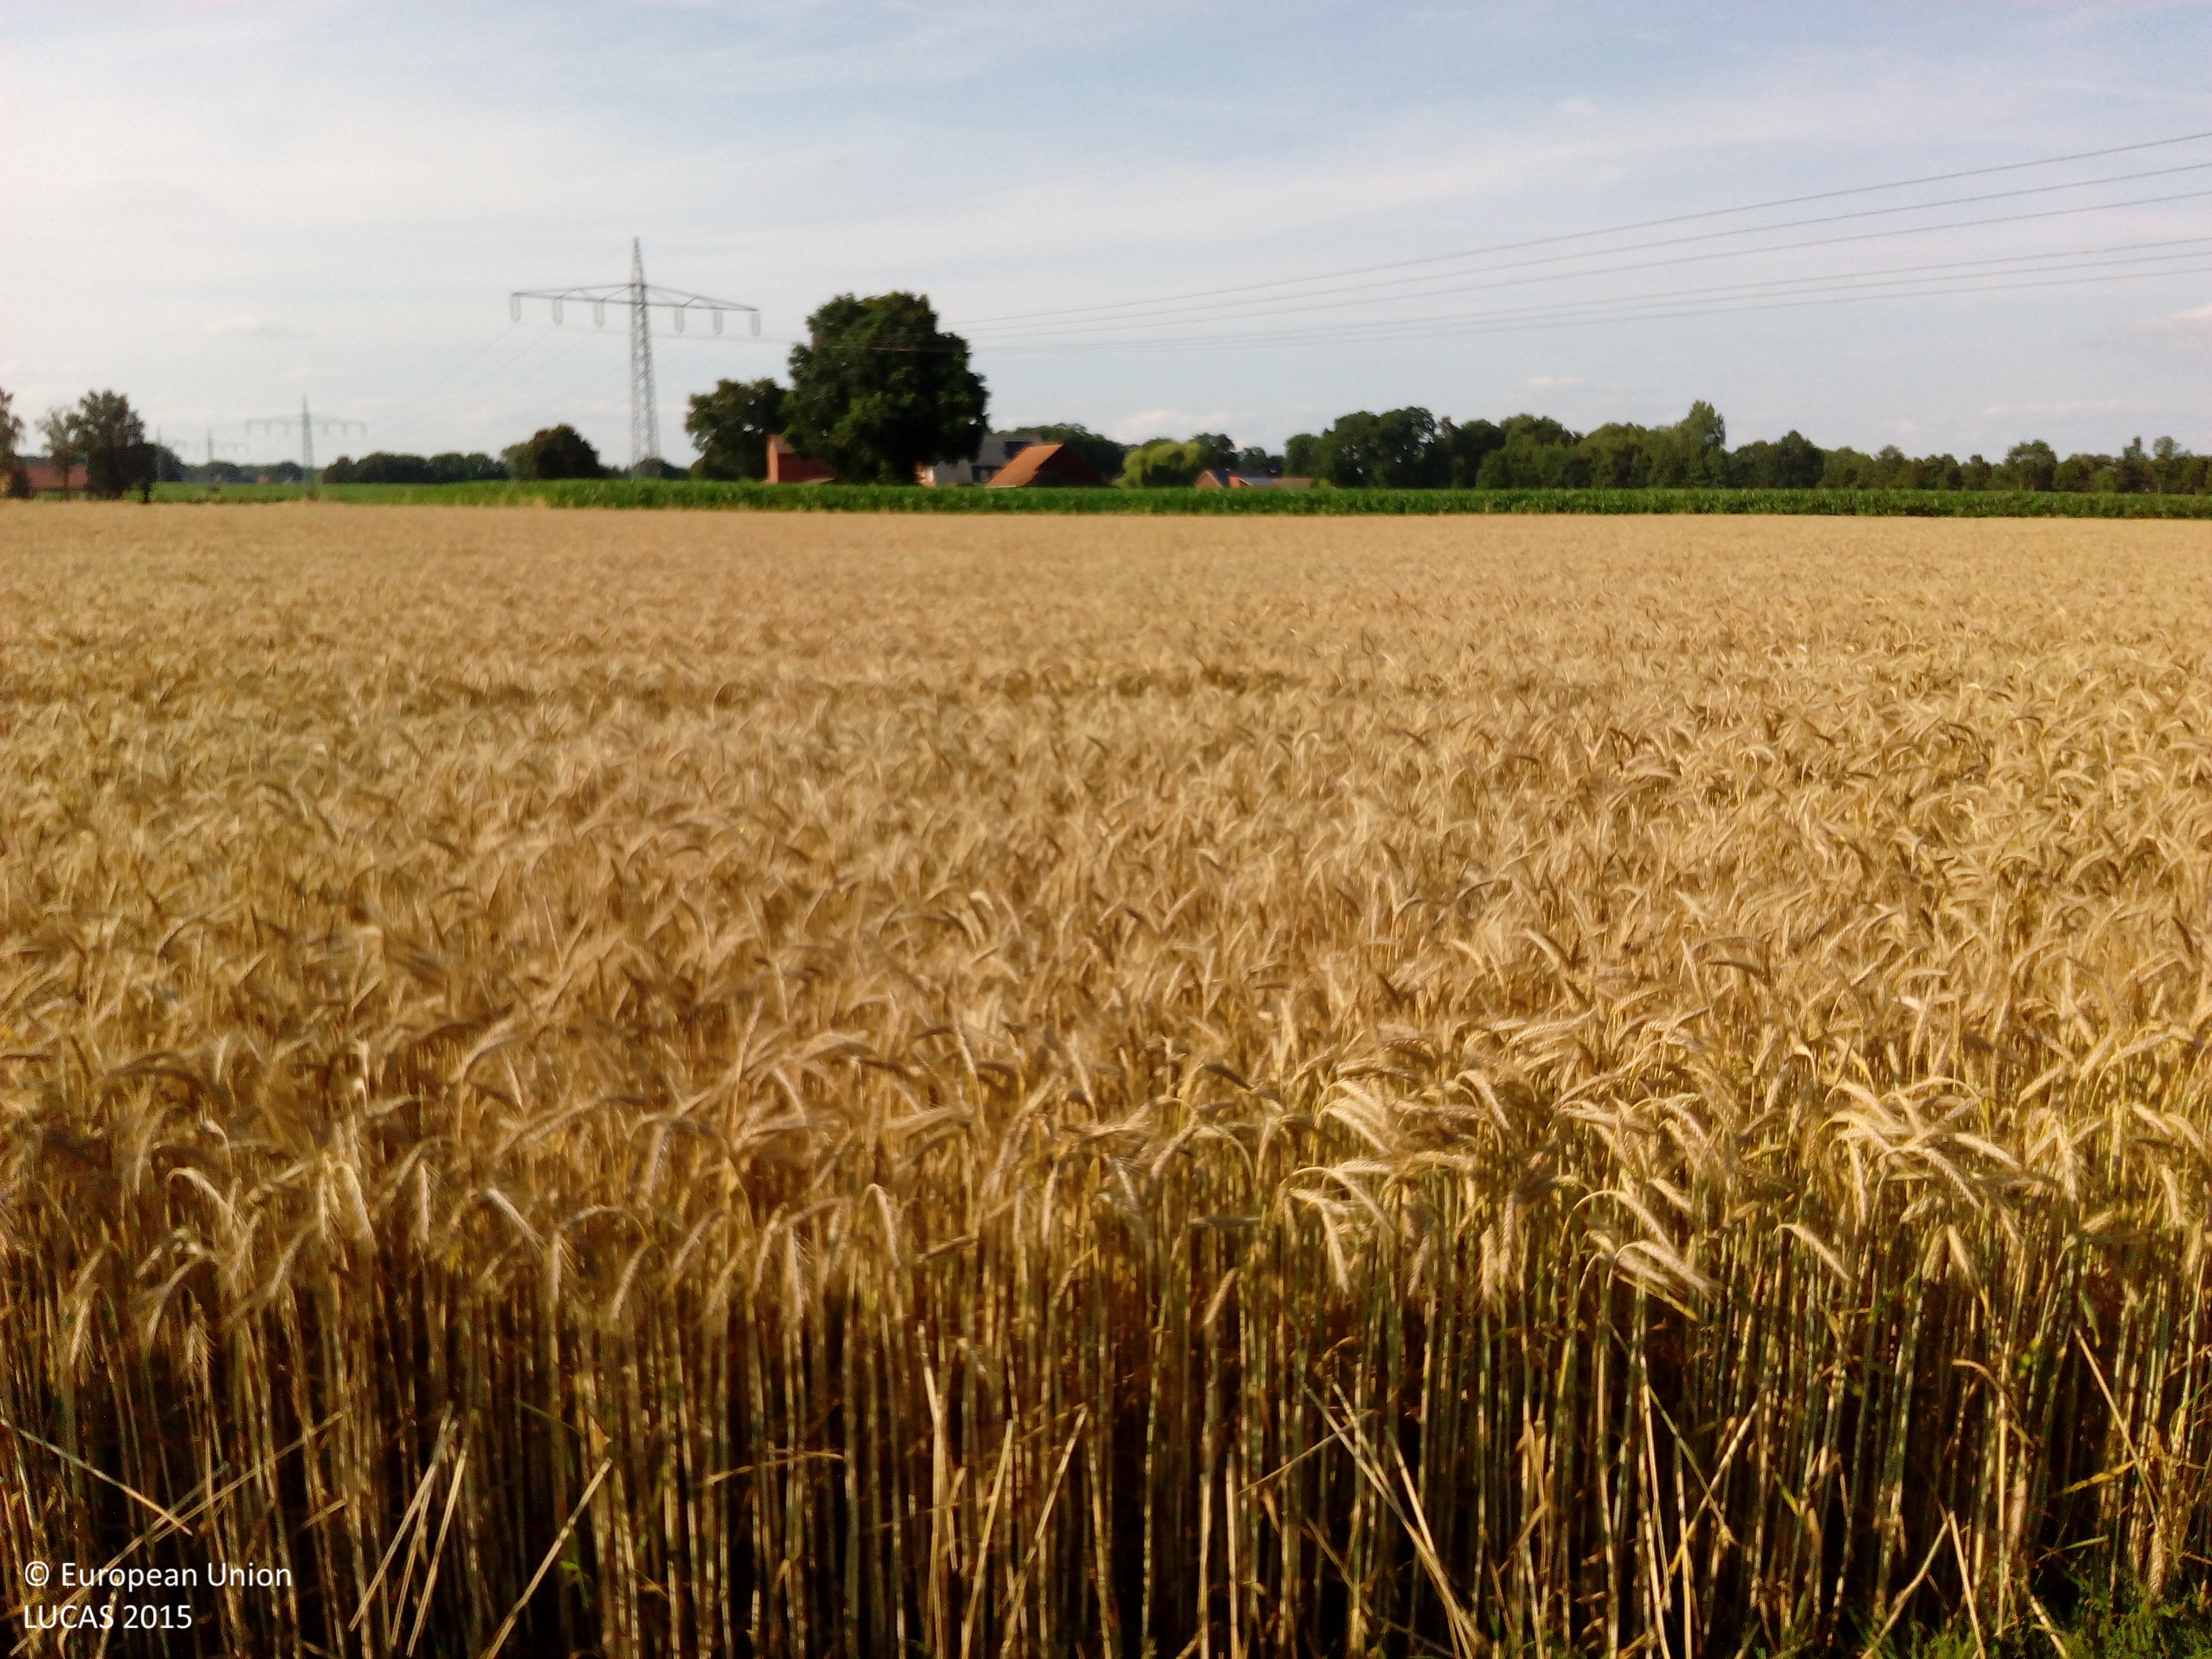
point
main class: Cropland
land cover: Barley
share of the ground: > 75 %
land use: Agriculture (excluding fallow land and kitchen gardens)
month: July
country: DE
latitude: 52.4857
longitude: 7.9536
